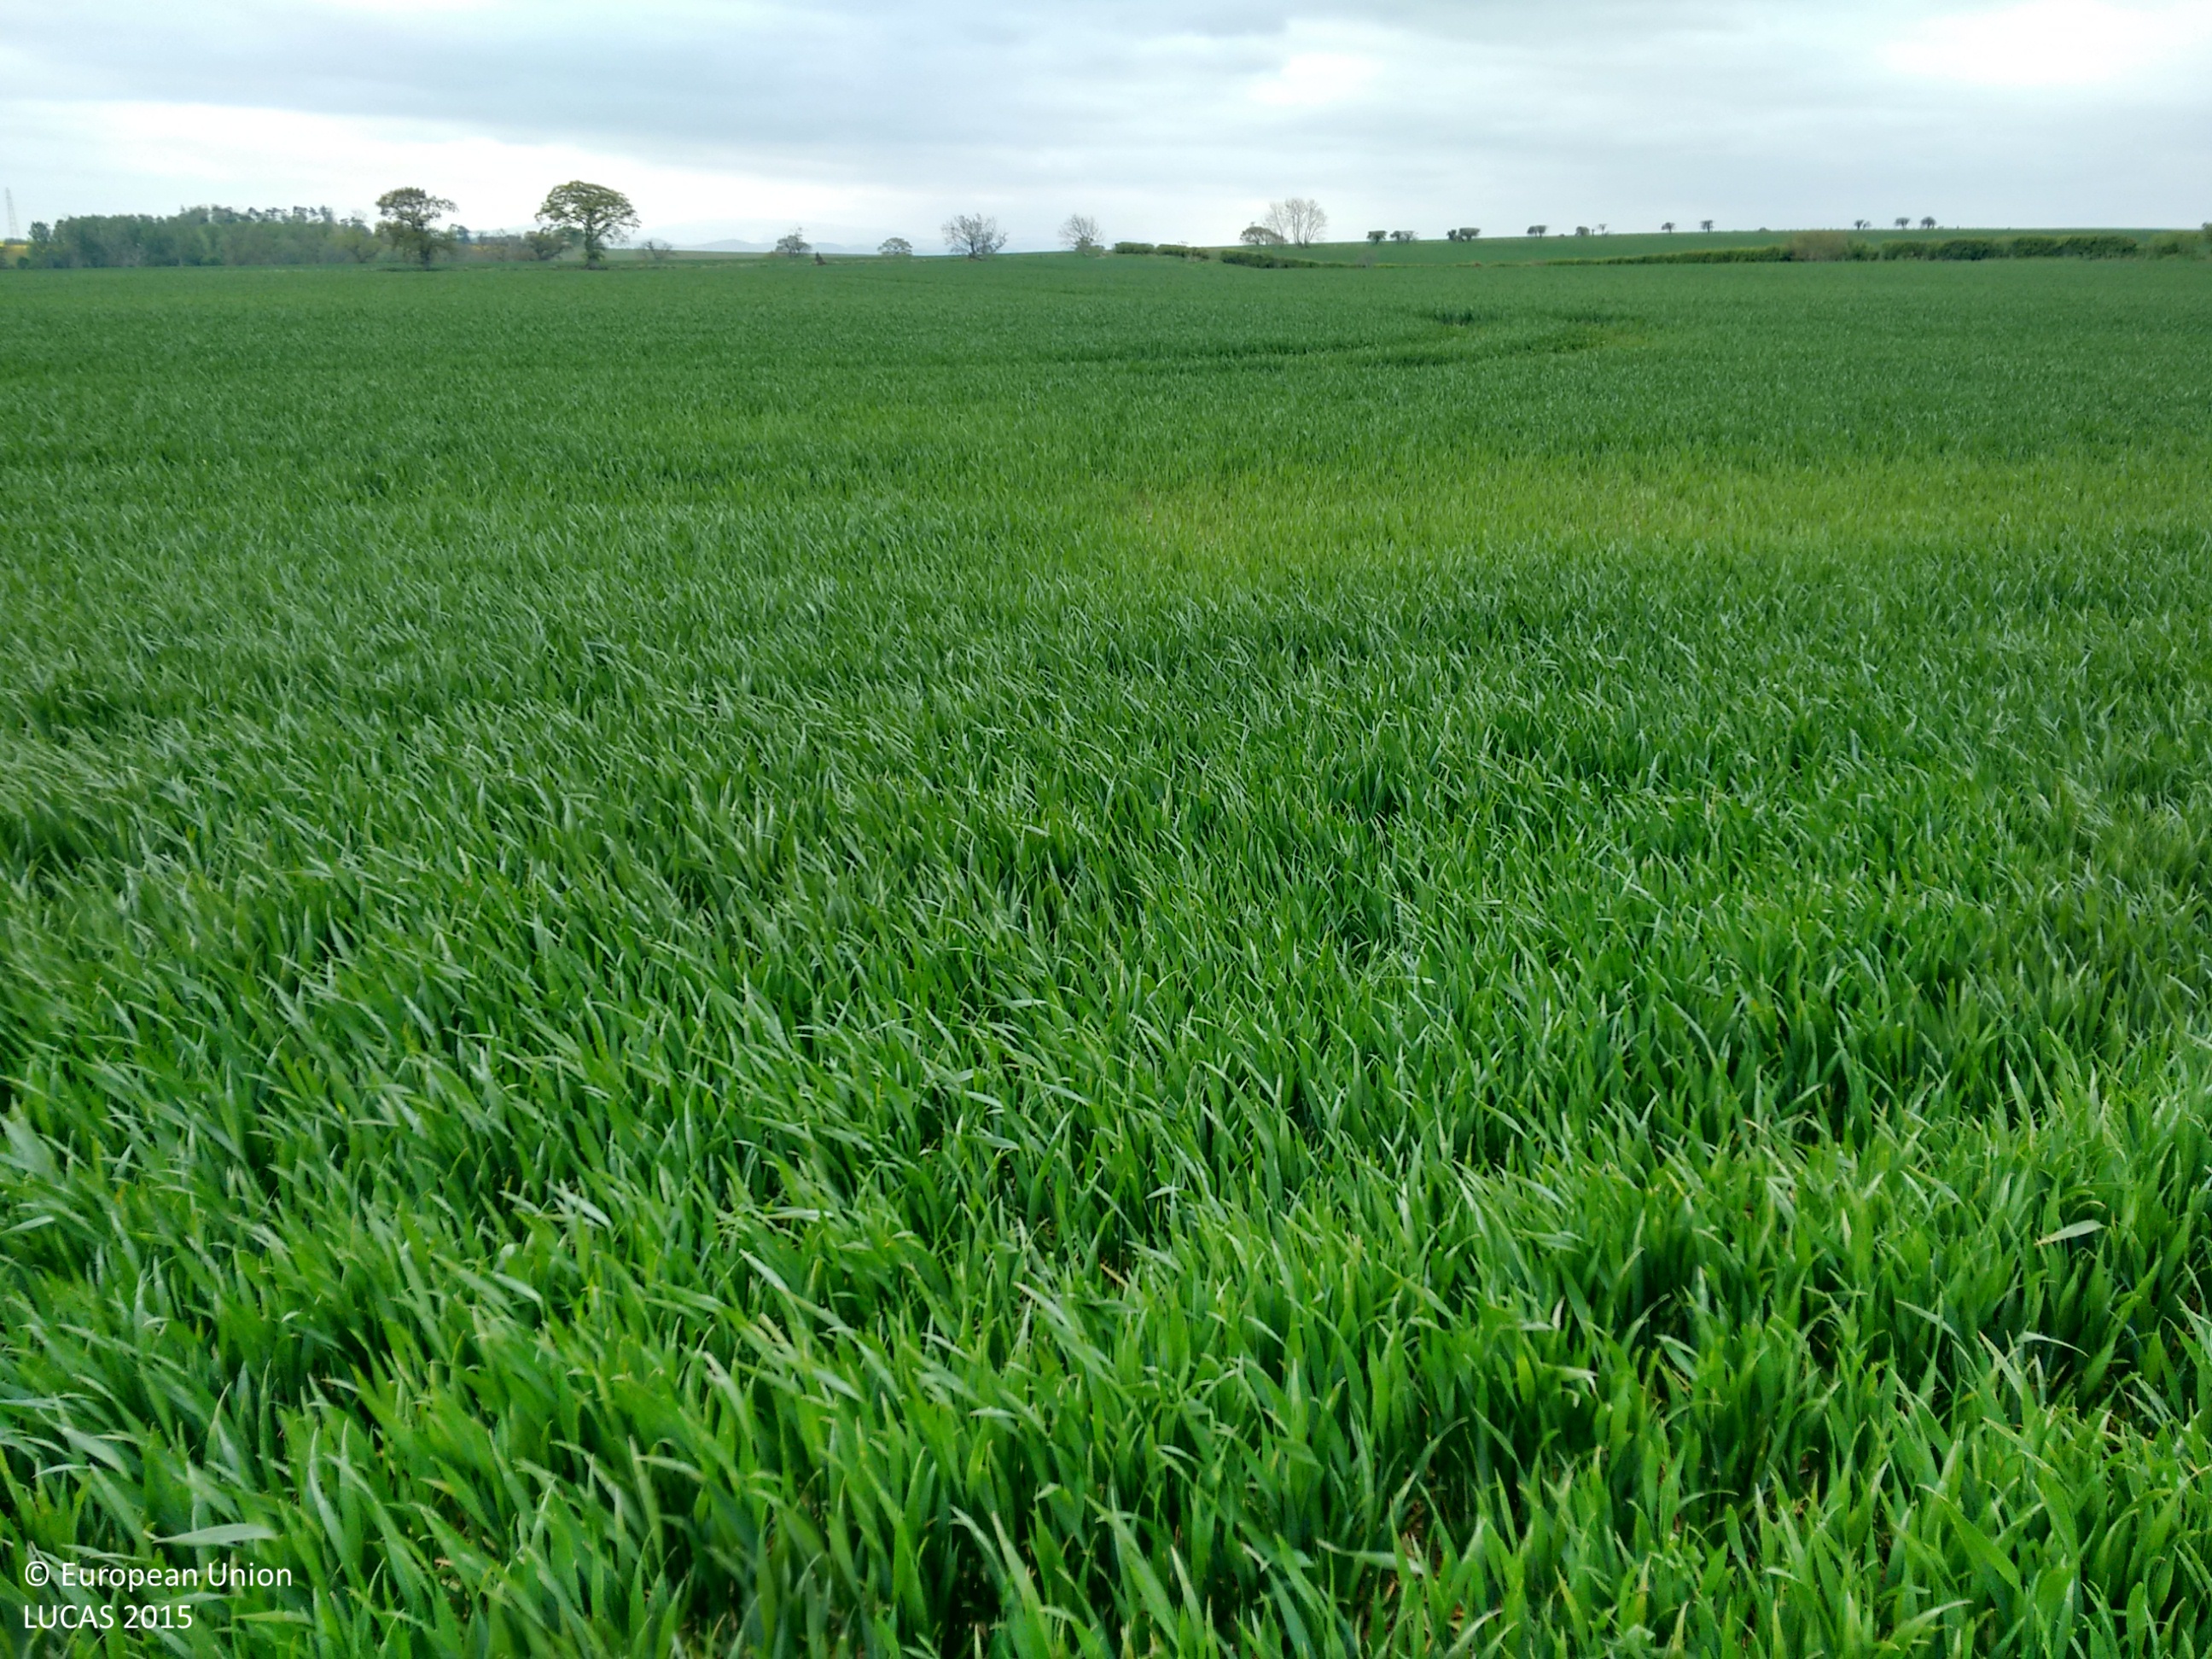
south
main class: Cropland
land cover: Common wheat
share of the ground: > 75 %
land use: Agriculture (excluding fallow land and kitchen gardens)
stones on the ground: < 10 %
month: May
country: GB
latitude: 55.7031
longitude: -2.2939
